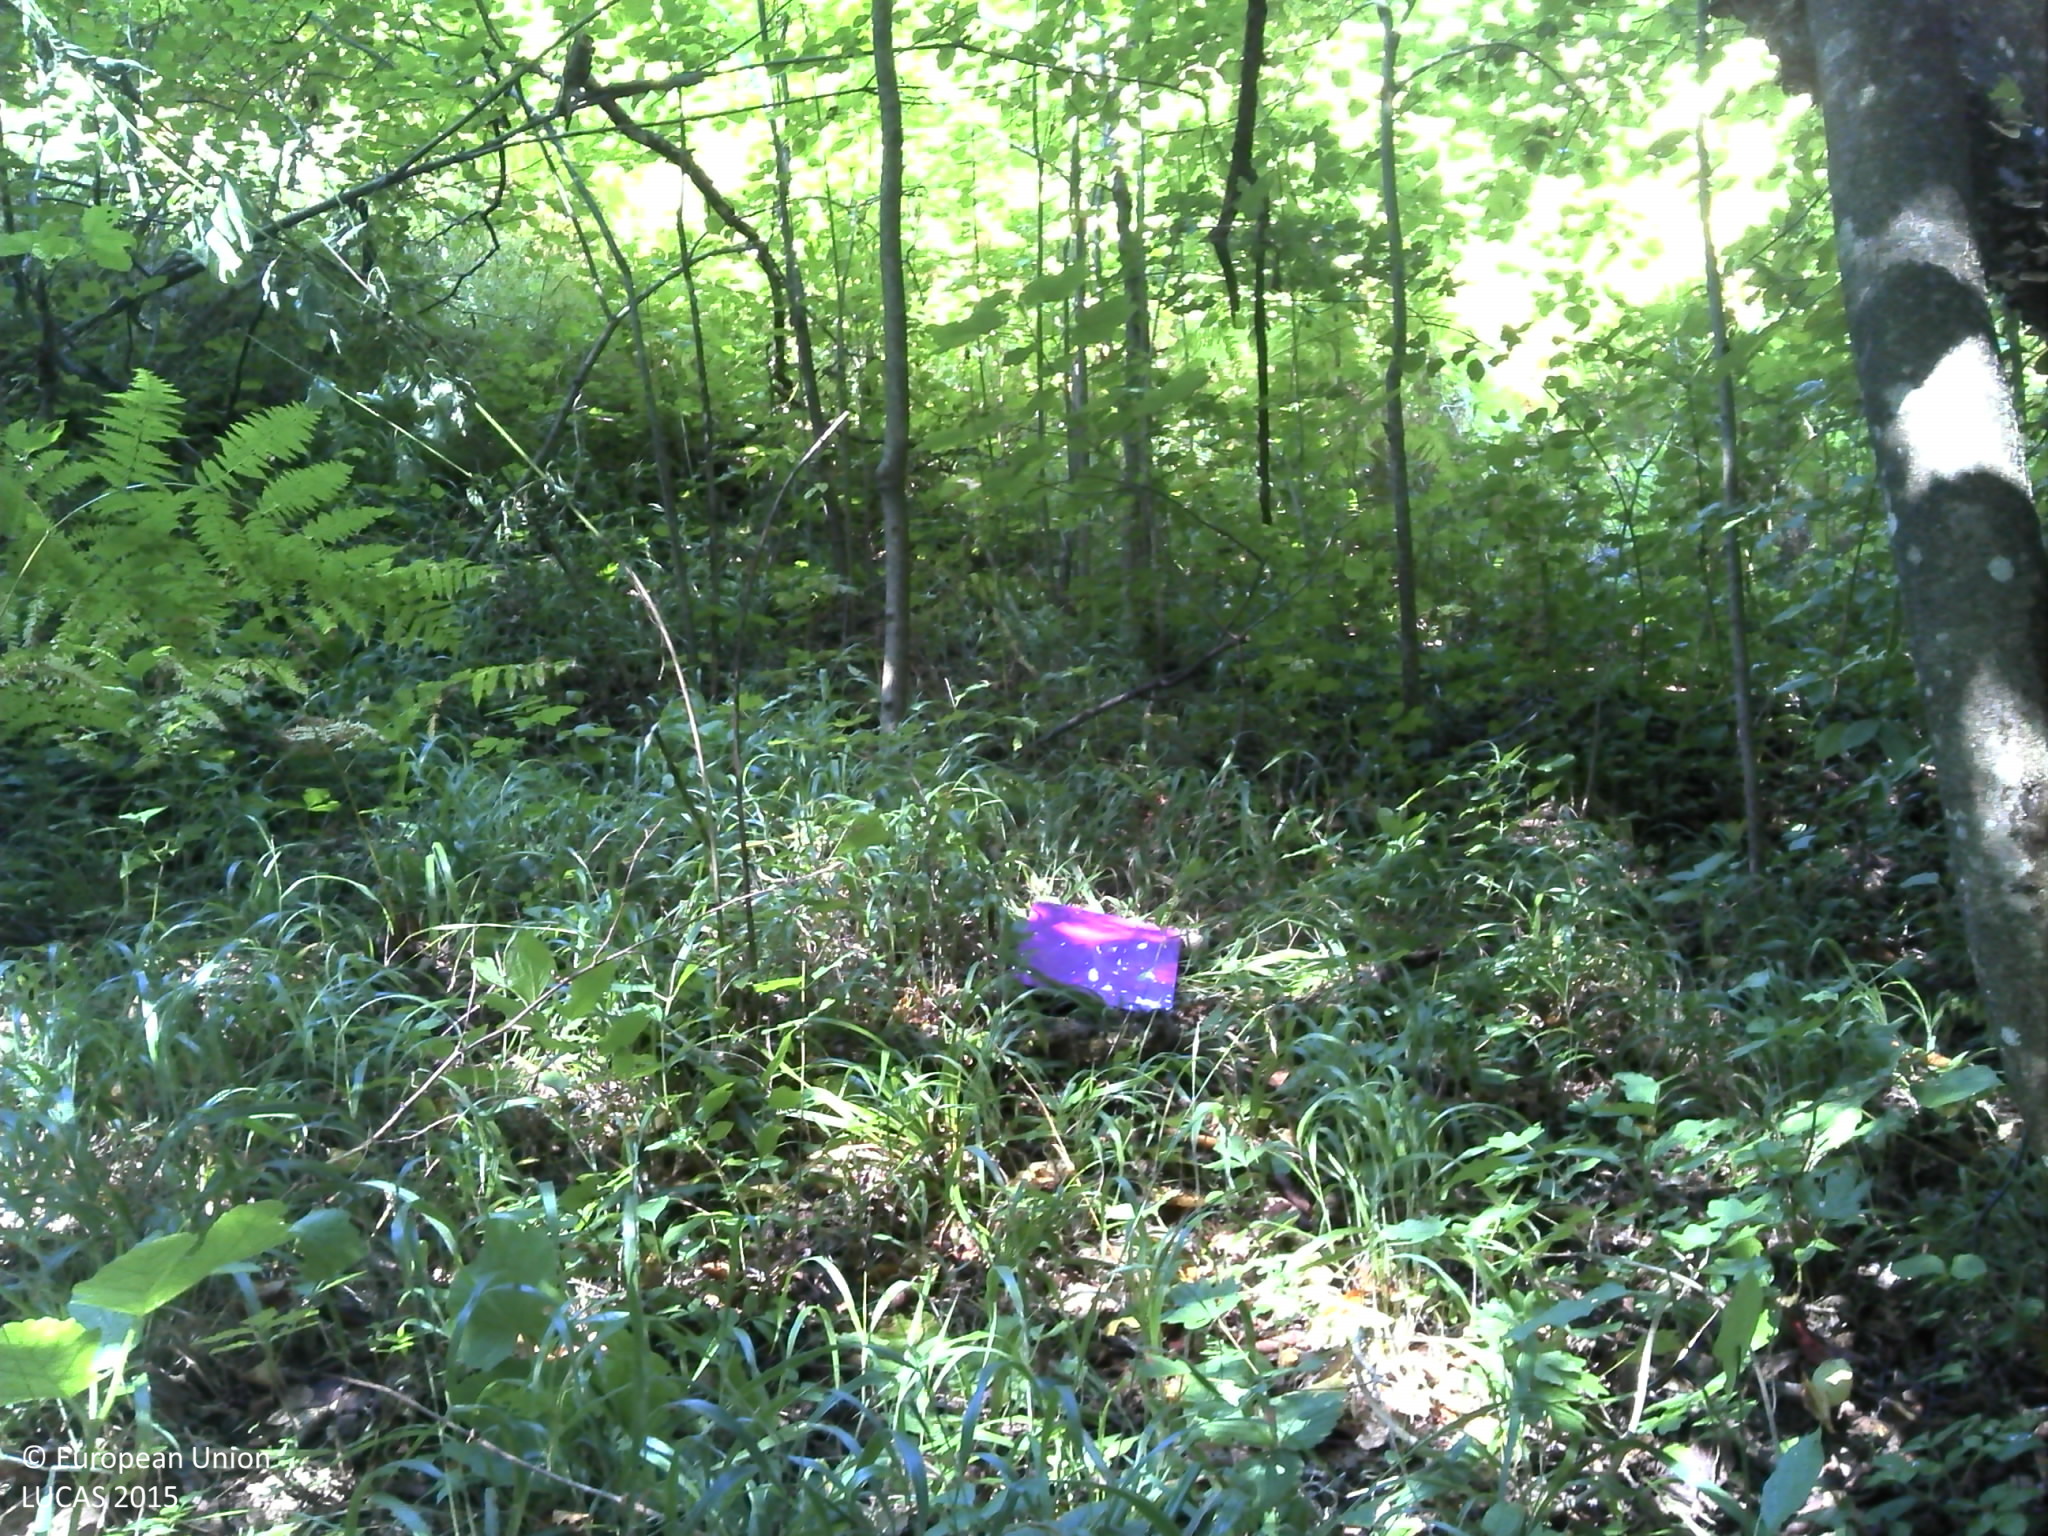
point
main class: Woodland
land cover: Broadleaved woodland
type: mesophytic deciduous forest
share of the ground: > 75 %
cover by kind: broadleaved forest trees 95 %, herbaceous plants 5 %
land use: Forestry
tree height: > 5 m
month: September
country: HR
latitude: 44.9371
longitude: 15.6592
